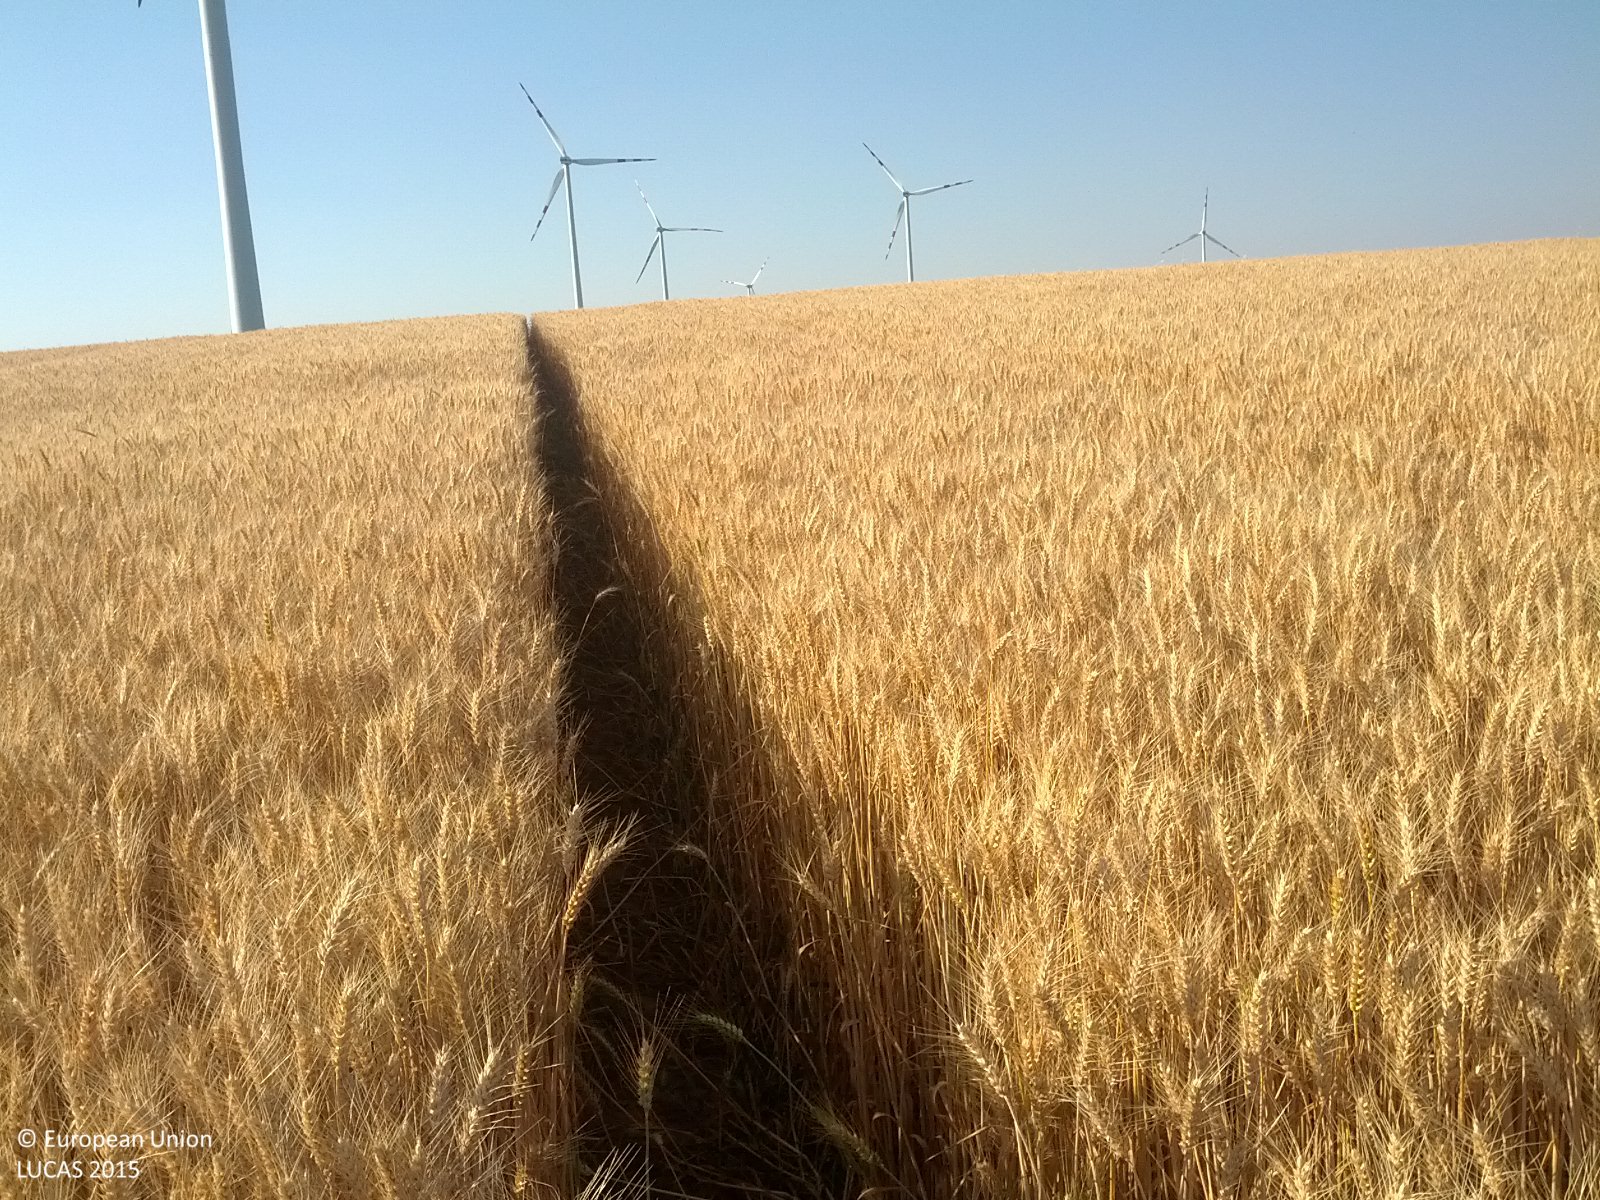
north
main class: Cropland
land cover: Common wheat
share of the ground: > 75 %
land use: Agriculture (excluding fallow land and kitchen gardens)
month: July
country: AT
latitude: 48.6206
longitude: 16.6133
